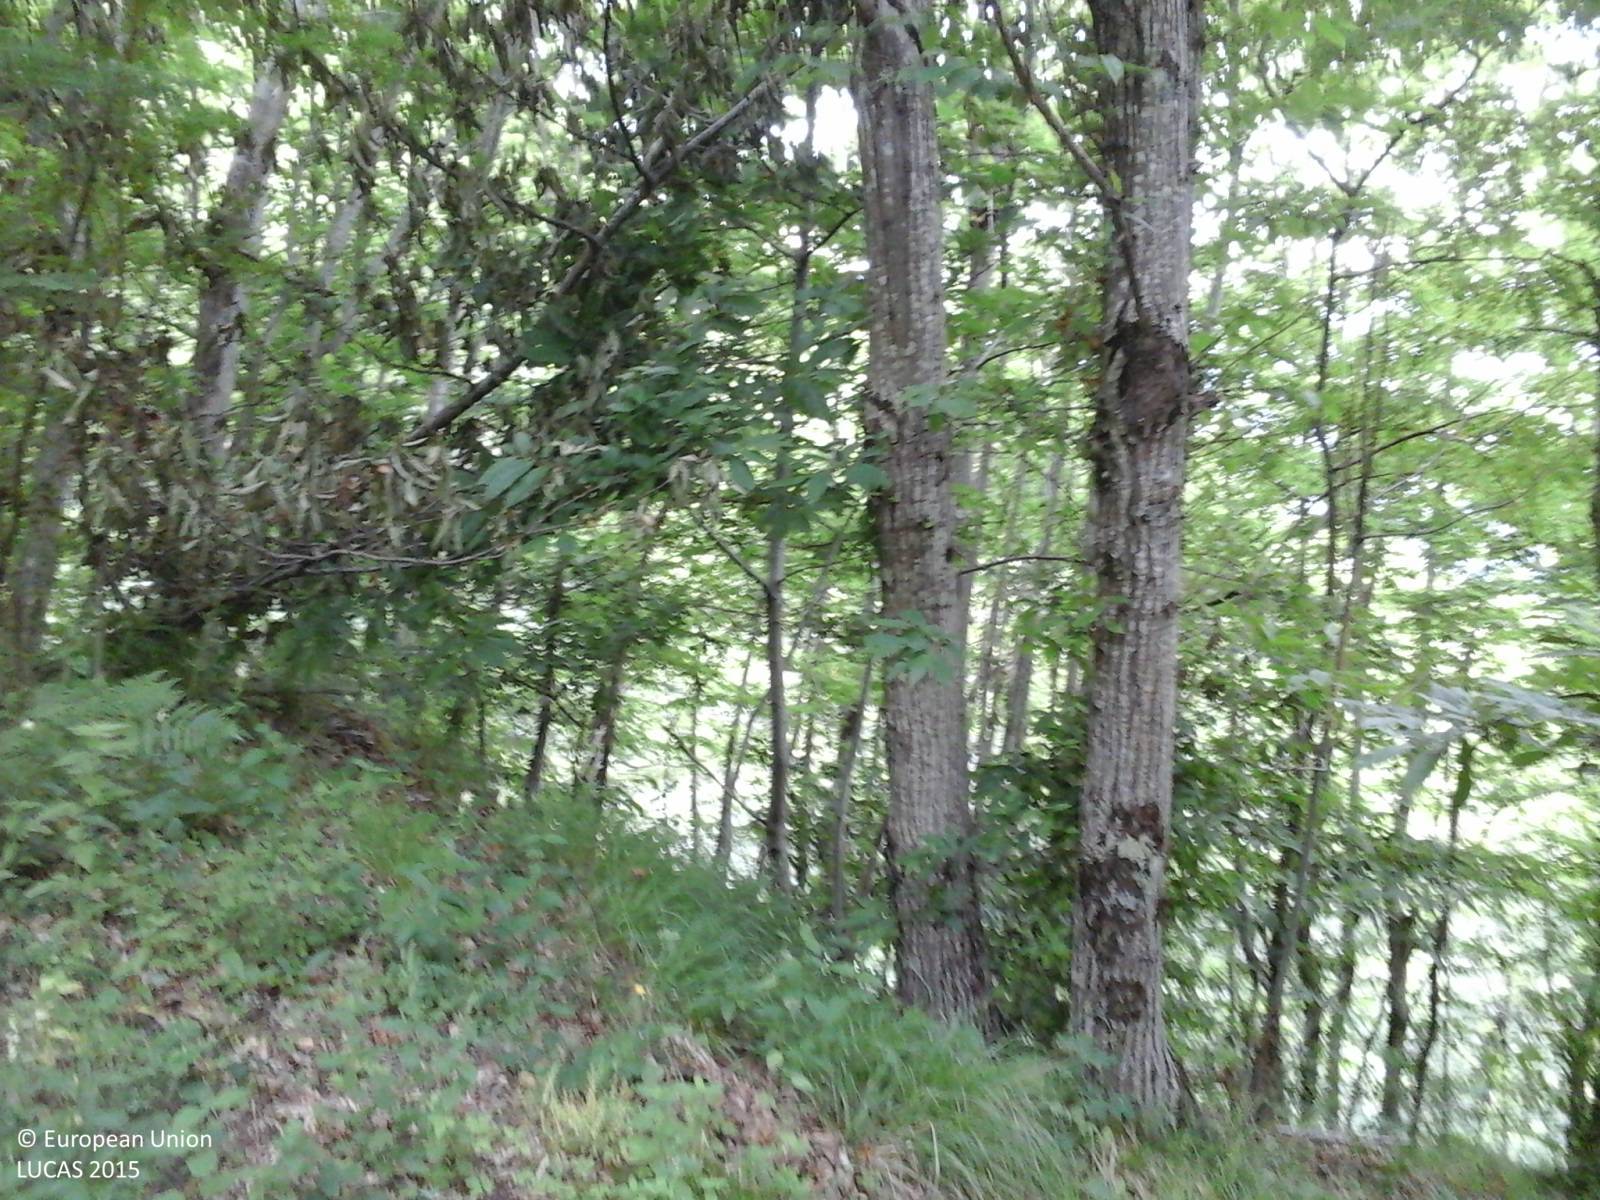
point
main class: Woodland
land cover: Broadleaved woodland
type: thermophilous deciduous forest
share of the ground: > 75 %
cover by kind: broadleaved forest trees 100 %
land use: Forestry
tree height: > 5 m
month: June
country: IT
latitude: 44.1335
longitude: 10.3367
